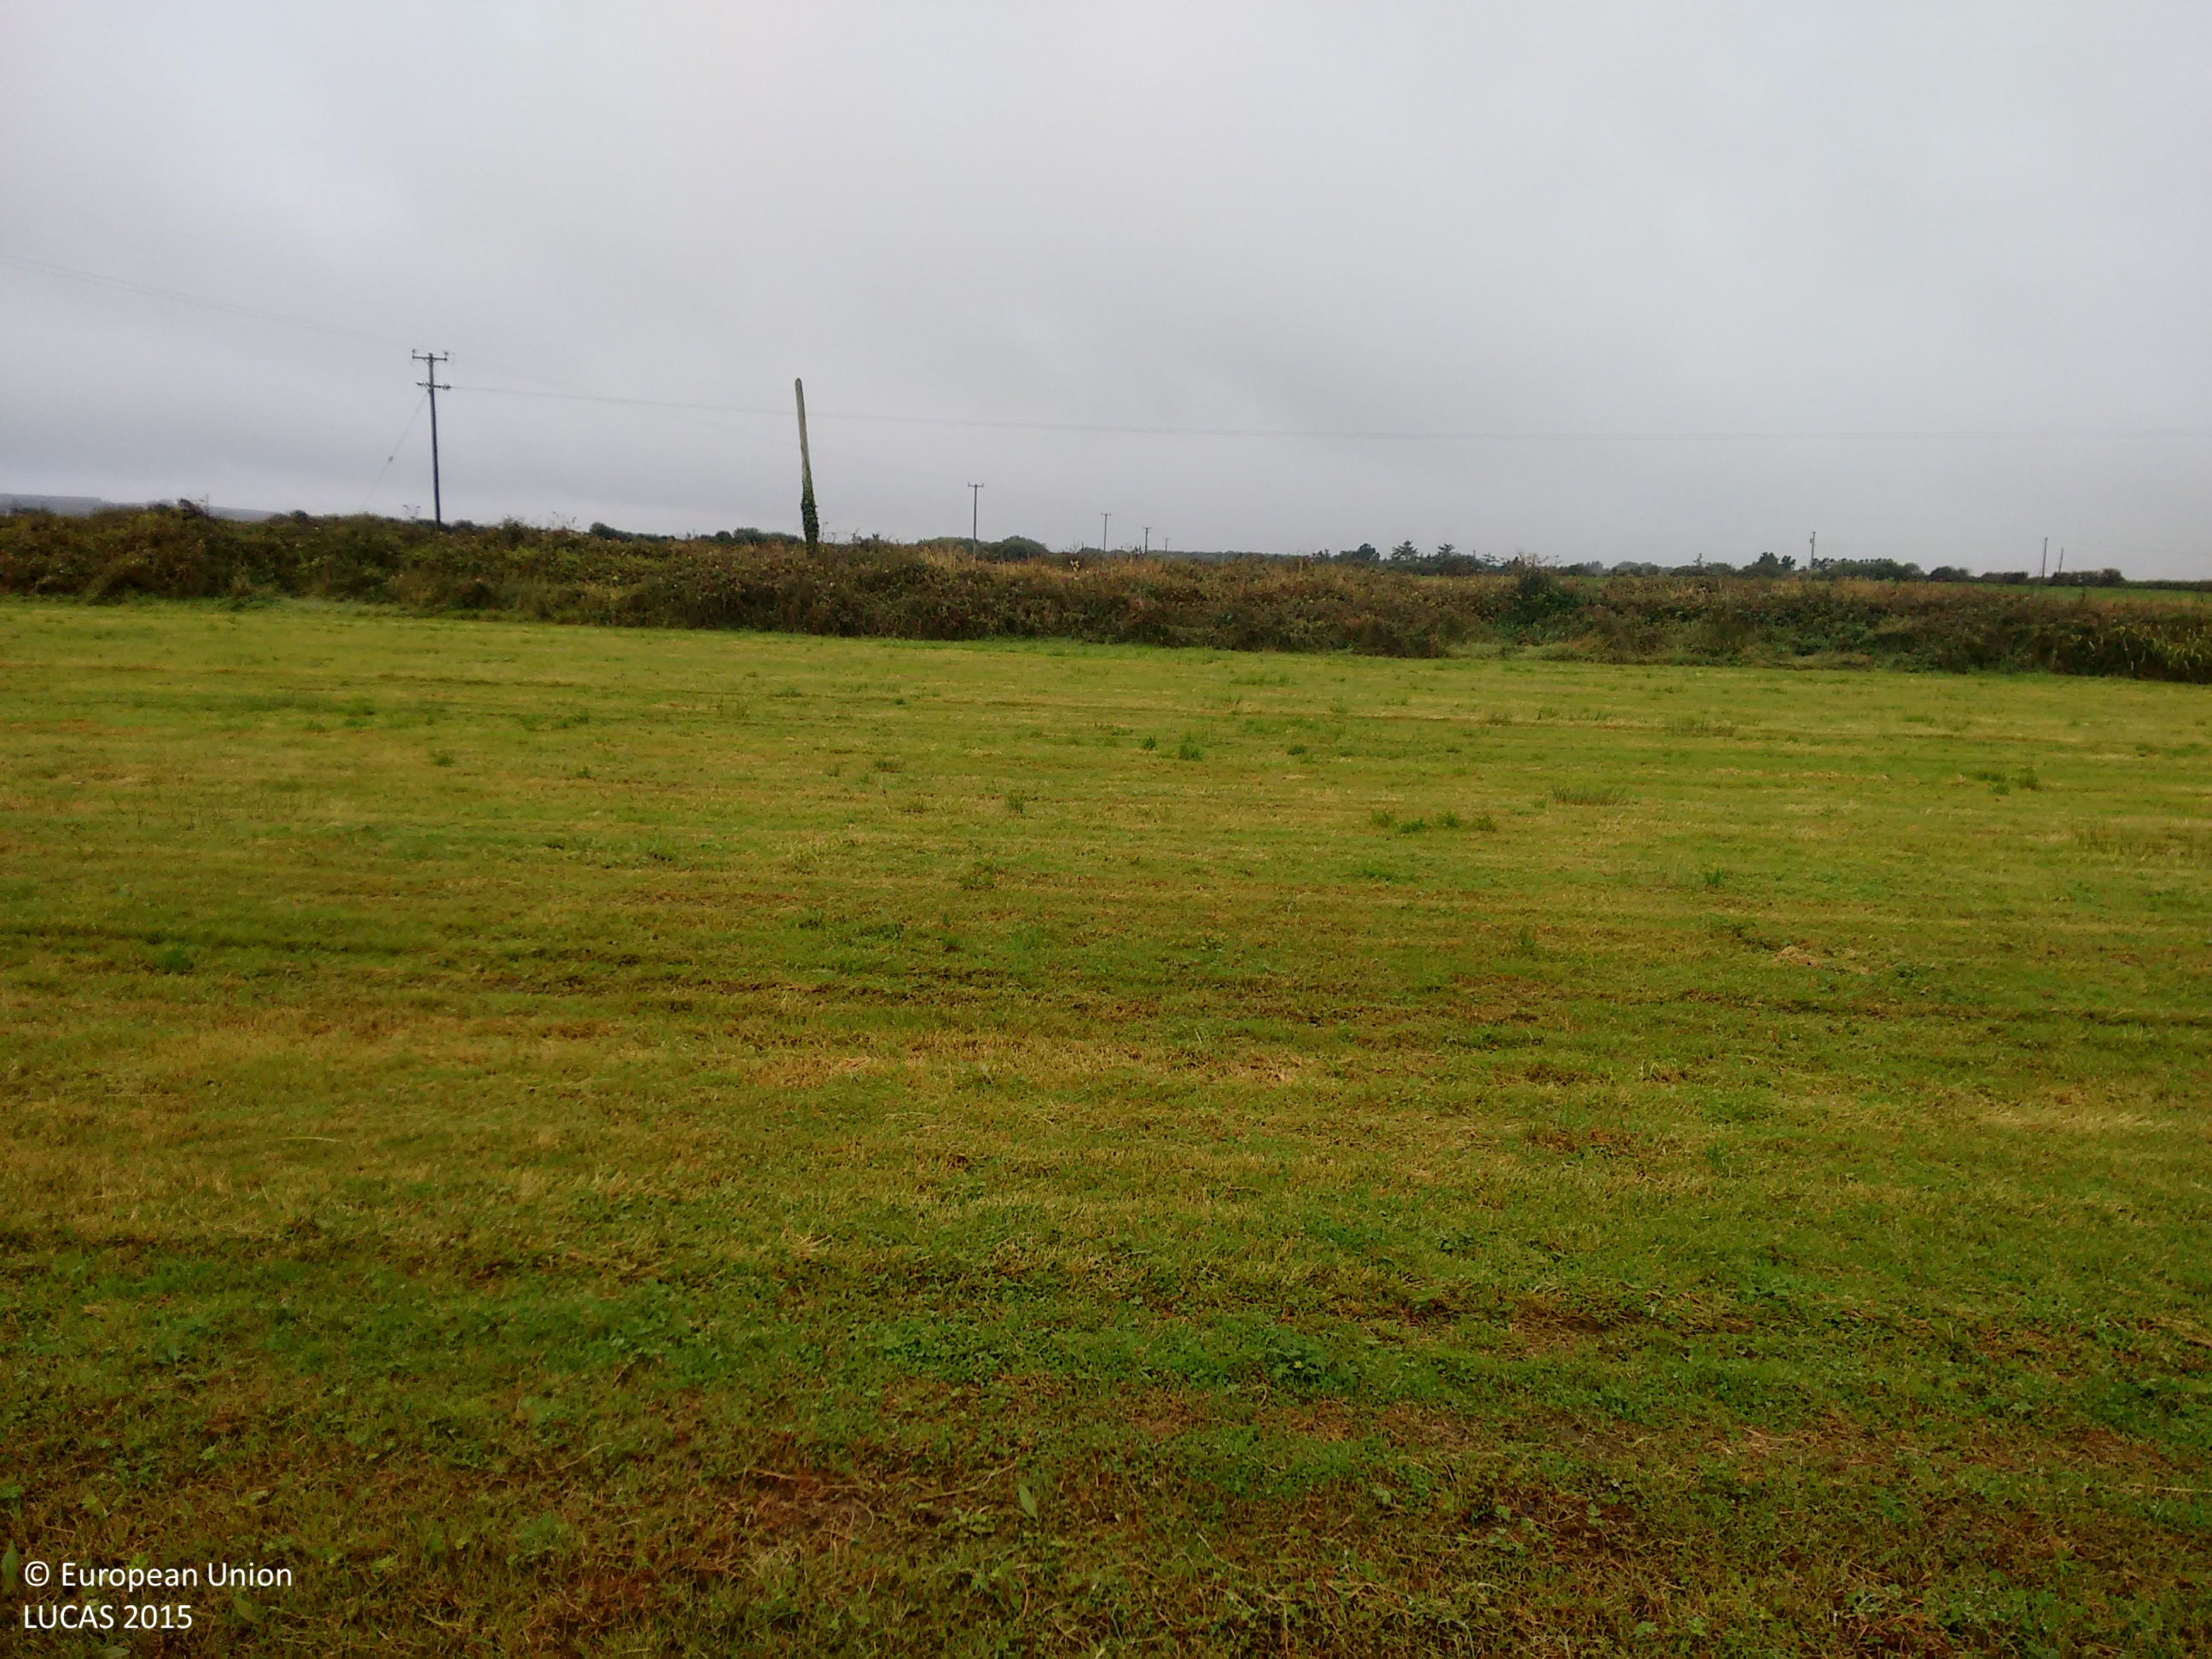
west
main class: Grassland
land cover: Grassland without tree/shrub cover
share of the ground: > 75 %
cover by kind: herbaceous plants 95 %, unconsolidated bare surface 5 %
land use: Agriculture (excluding fallow land and kitchen gardens)
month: September
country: IE
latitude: 52.6717
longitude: -9.5644
